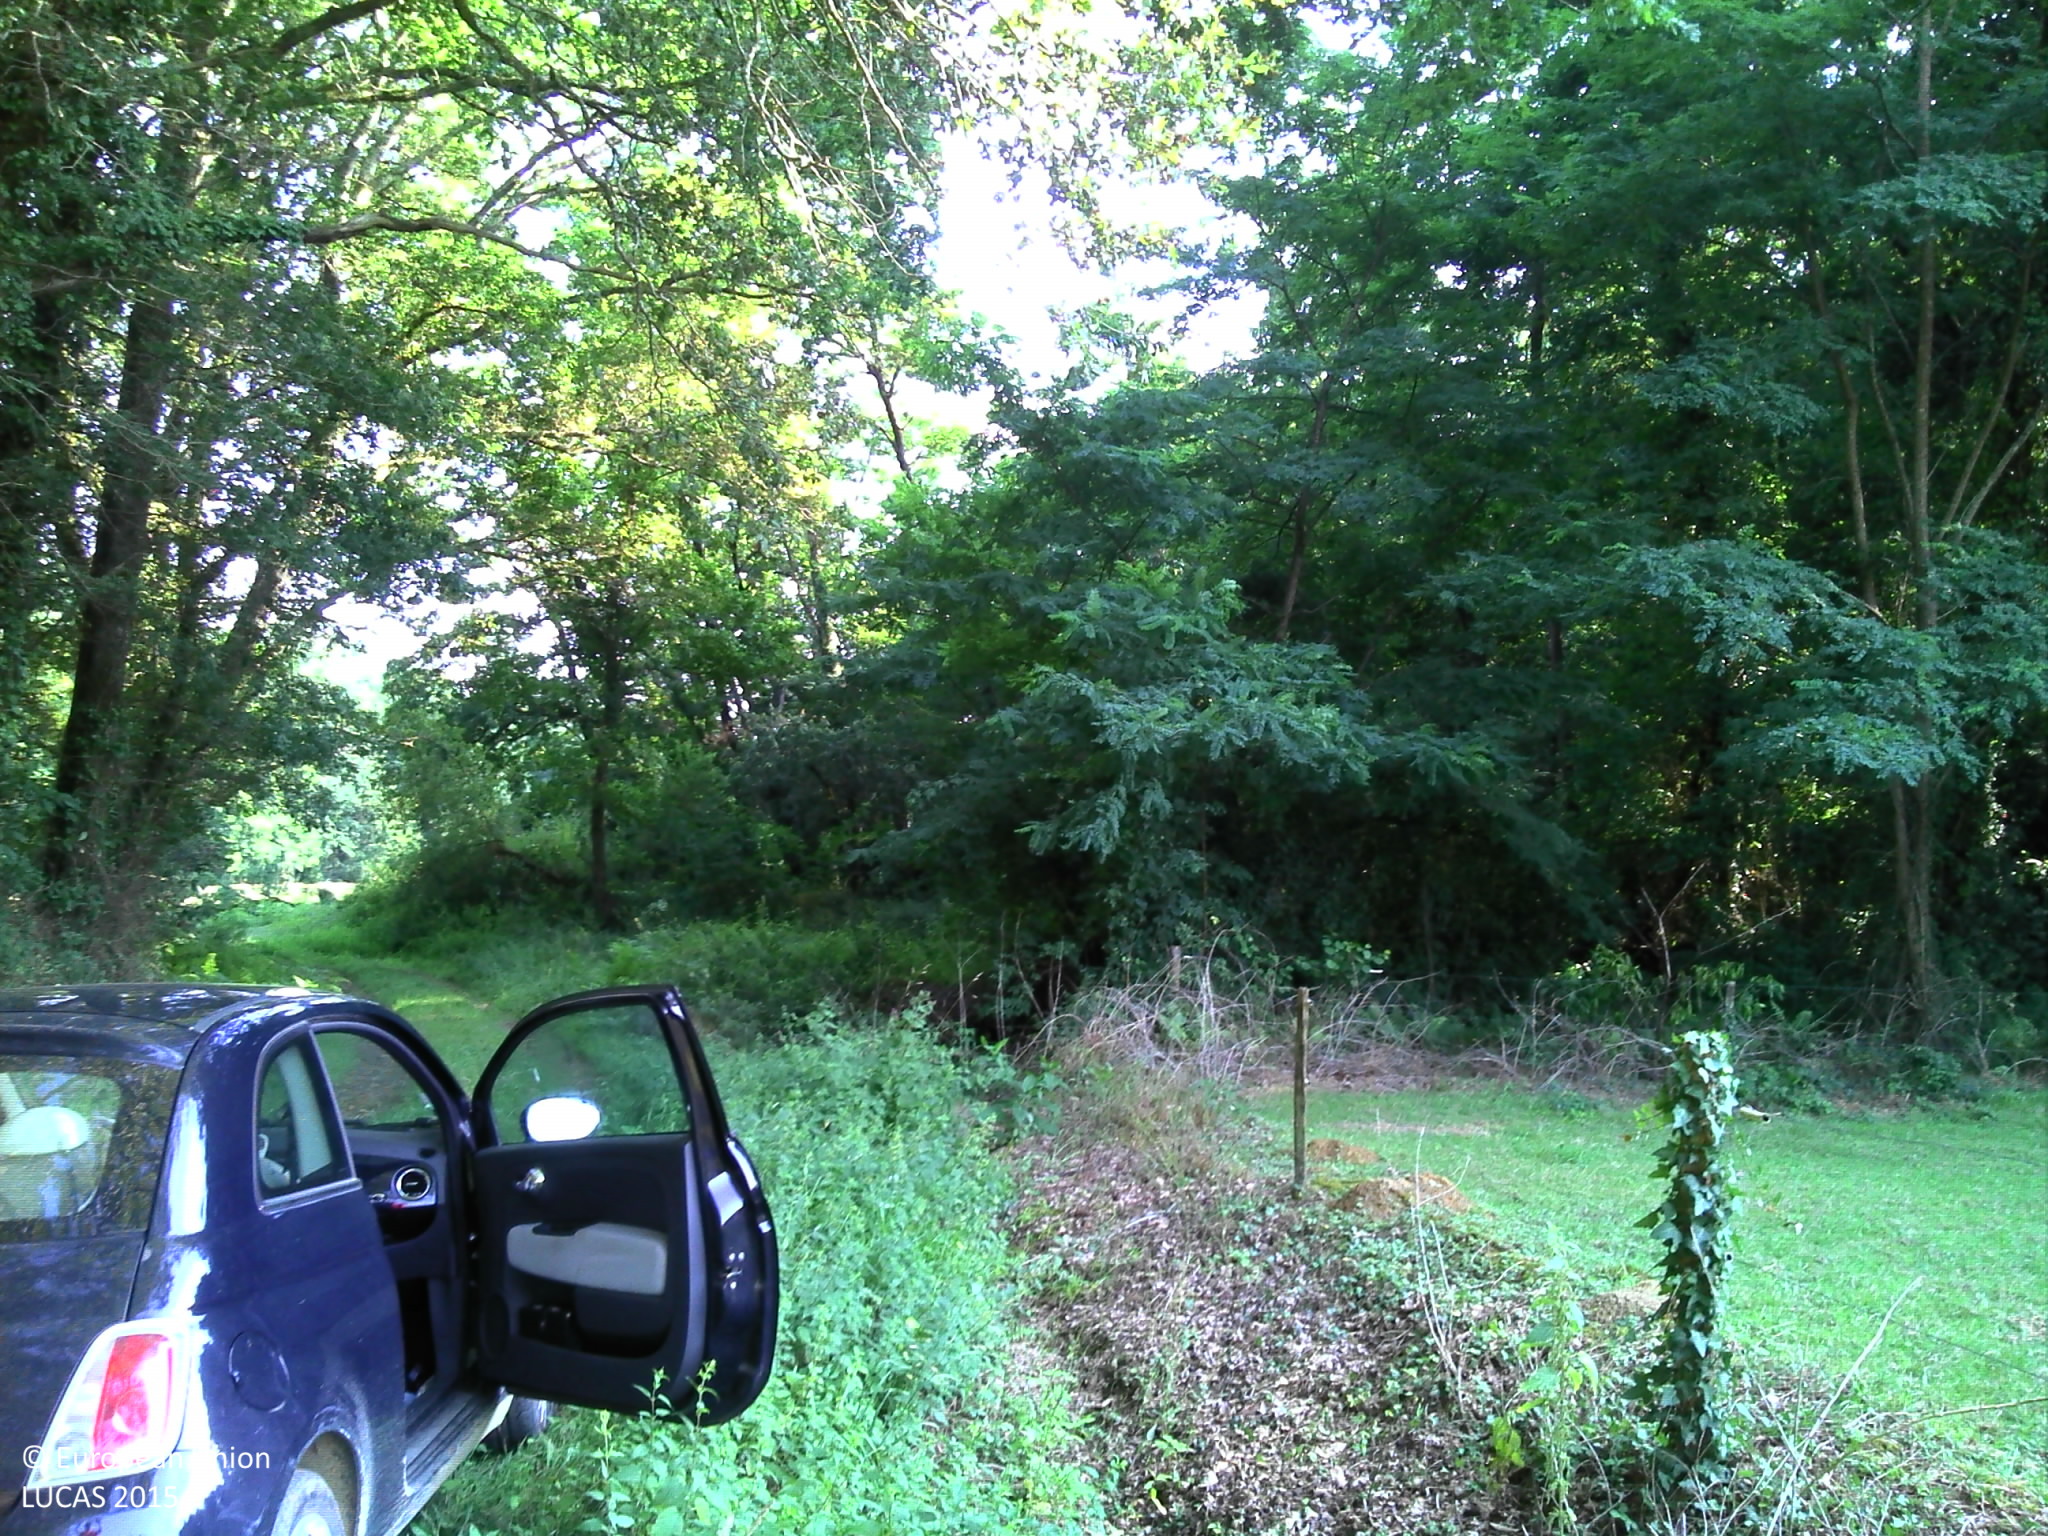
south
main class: Woodland
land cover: Broadleaved woodland
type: mesophytic deciduous forest
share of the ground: > 75 %
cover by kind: broadleaved forest trees 85 %, herbaceous plants 15 %
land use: Forestry
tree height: > 5 m
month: August
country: FR
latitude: 43.7483
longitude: -0.8053
